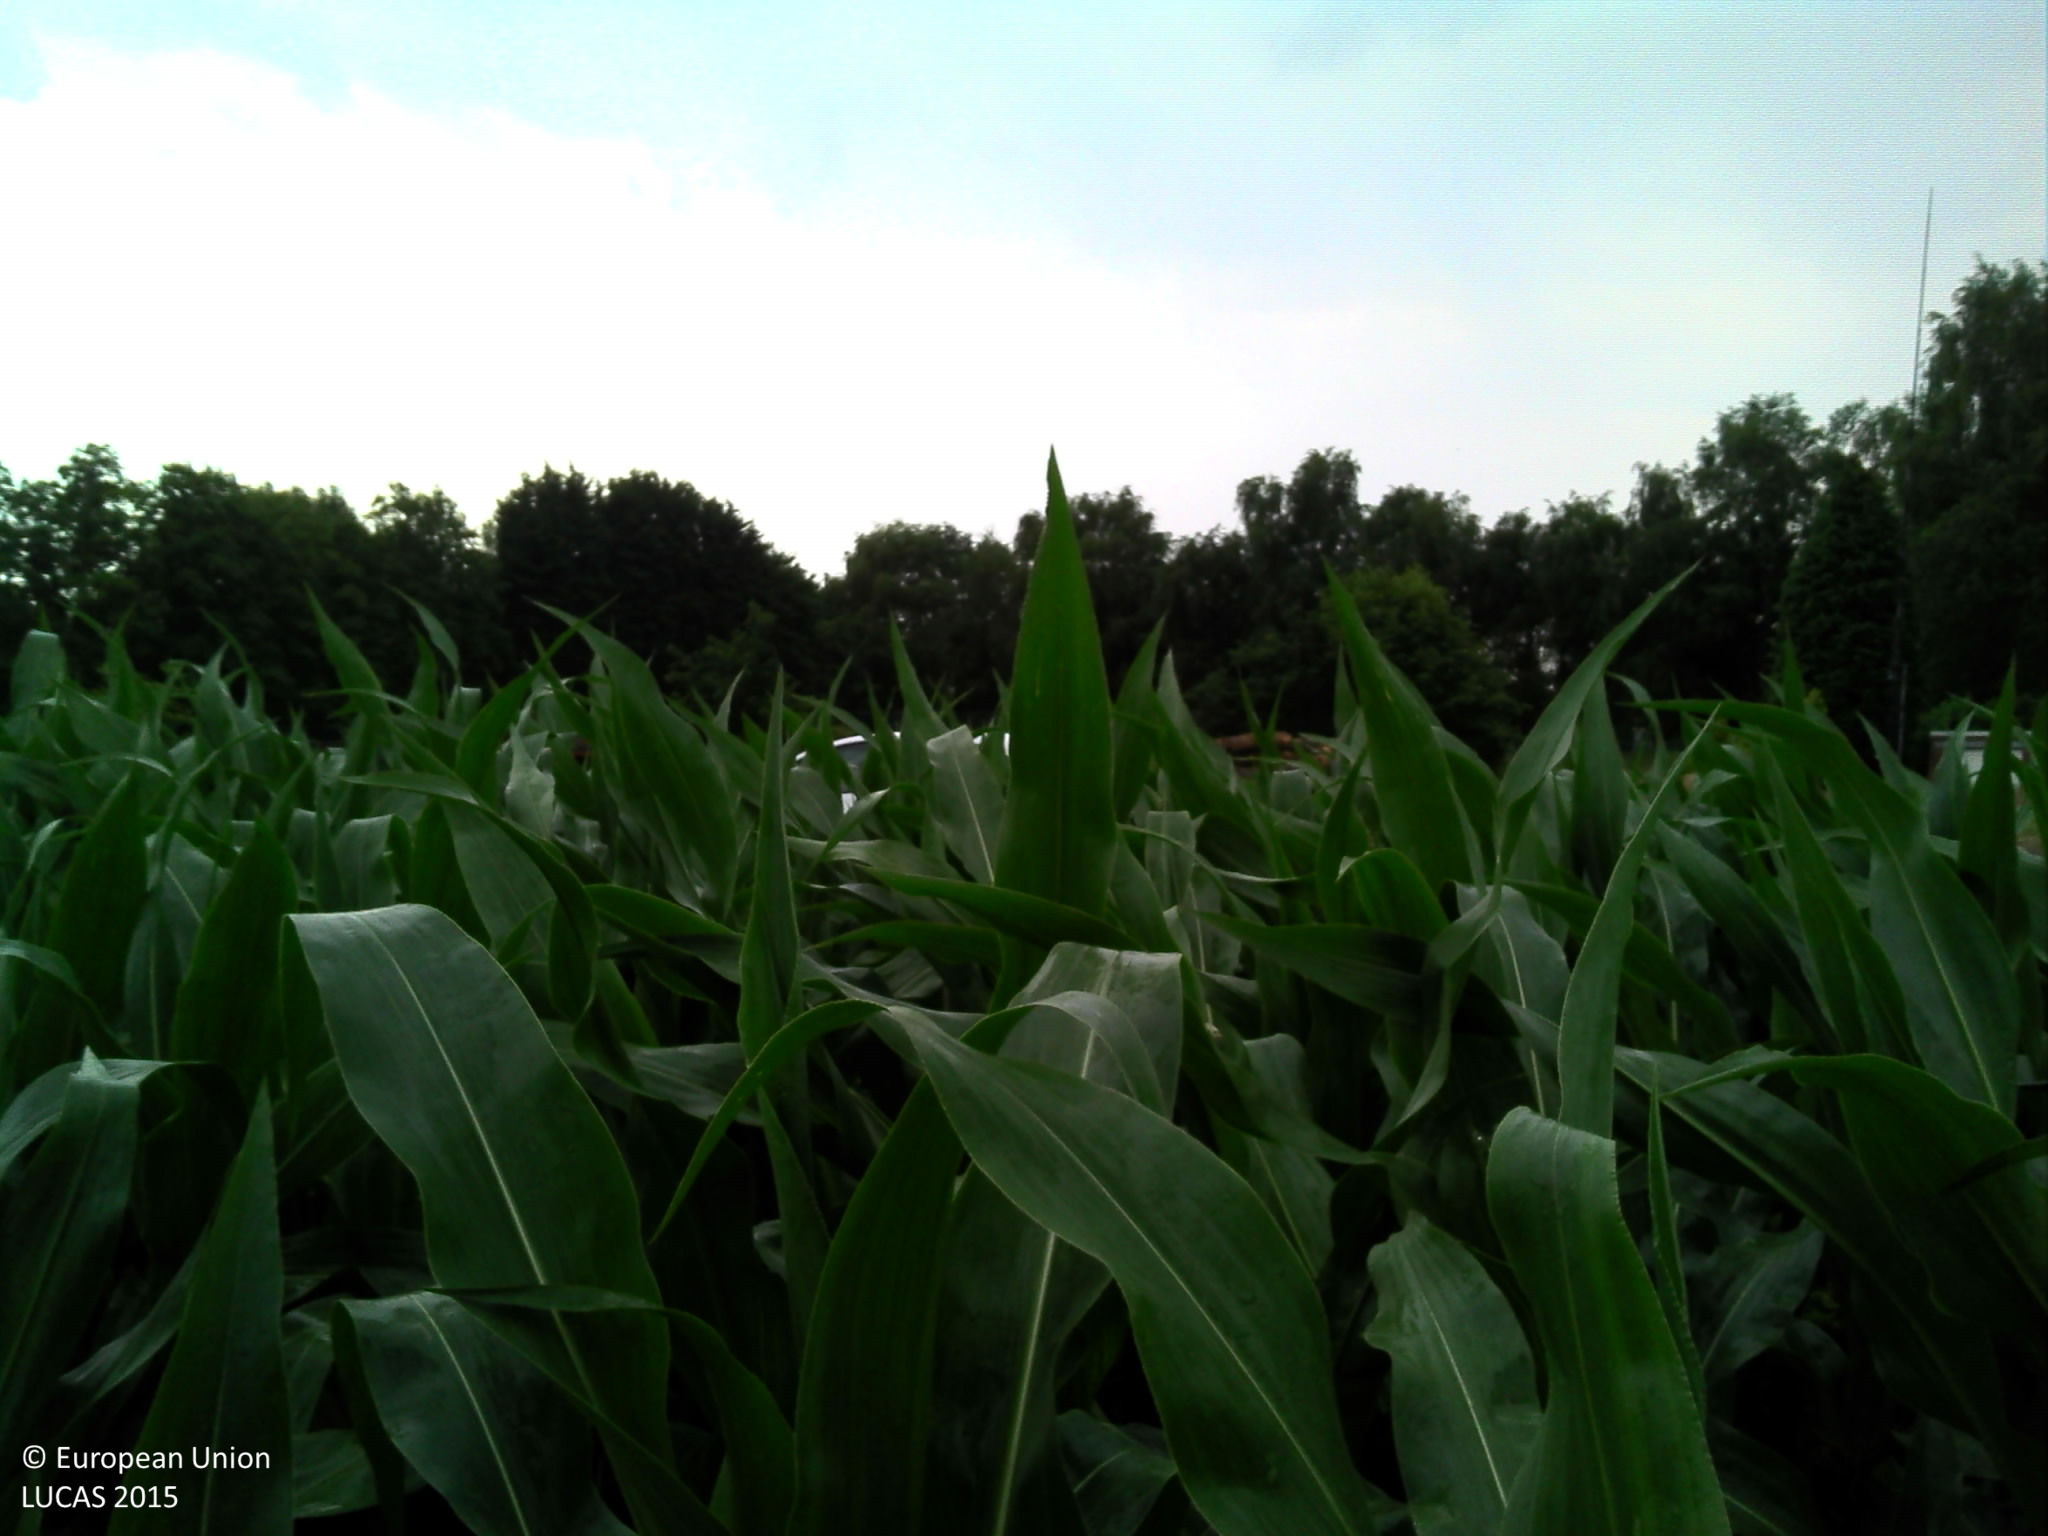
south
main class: Cropland
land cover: Maize
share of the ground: > 75 %
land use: Agriculture (excluding fallow land and kitchen gardens)
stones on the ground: < 10 %
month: July
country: BE
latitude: 51.2484
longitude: 3.5886
